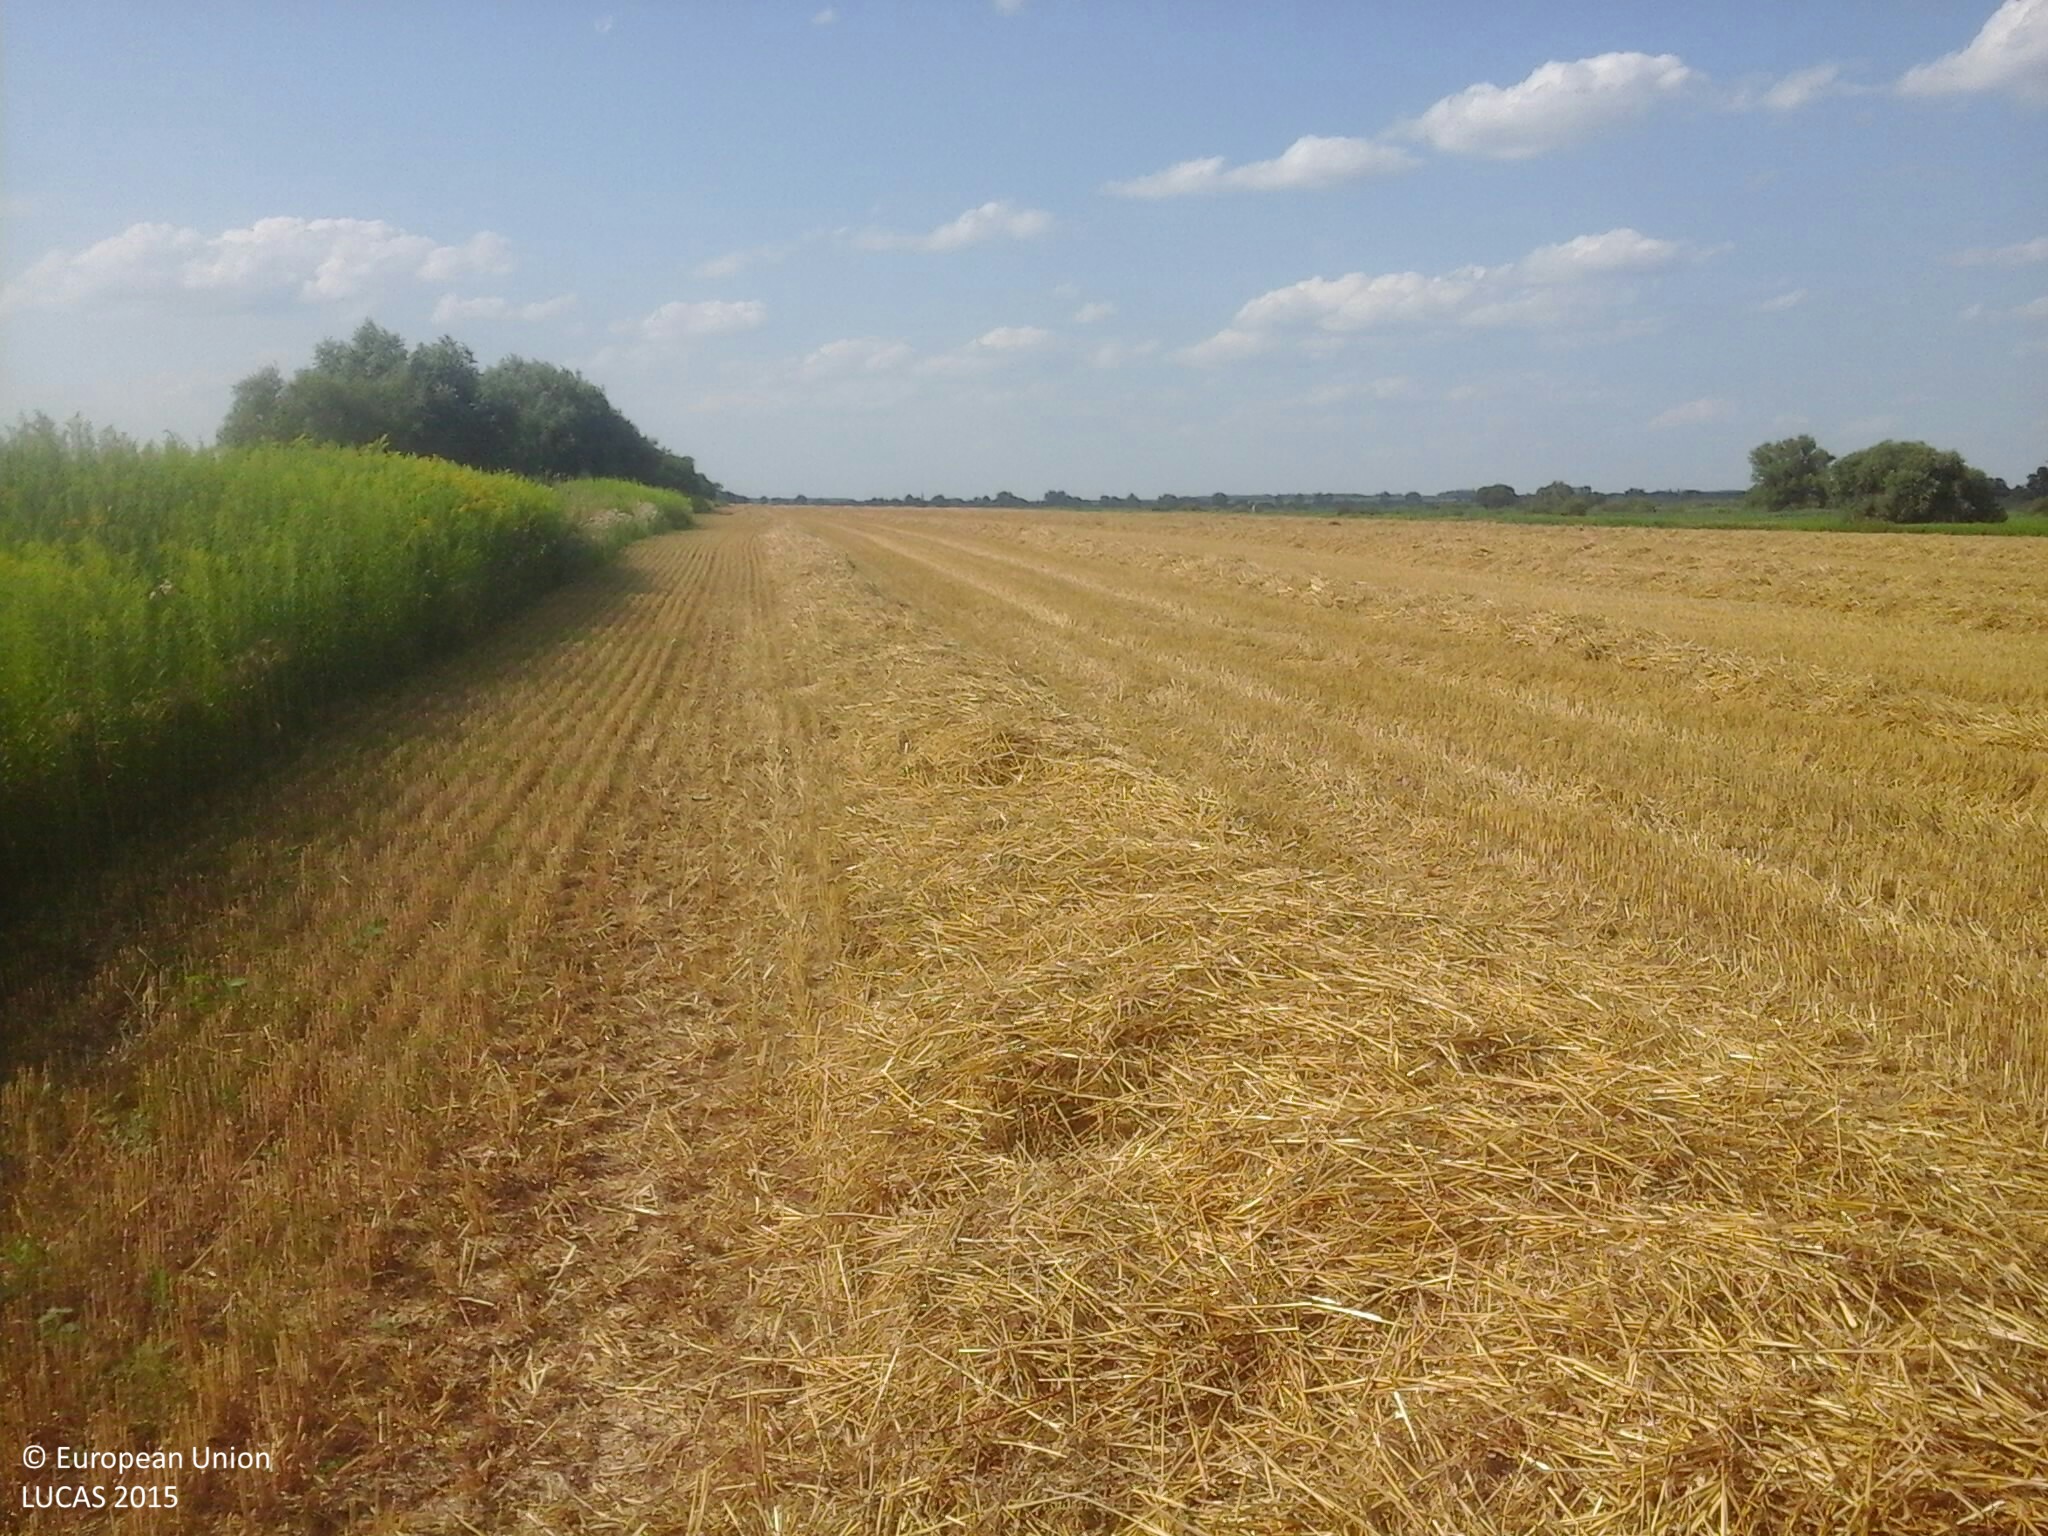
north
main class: Grassland
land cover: Spontaneously vegetated surfaces
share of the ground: > 75 %
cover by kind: herbaceous plants 100 %
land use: Semi-natural and natural areas not in use
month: July
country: HU
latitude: 46.9961
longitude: 17.1719
